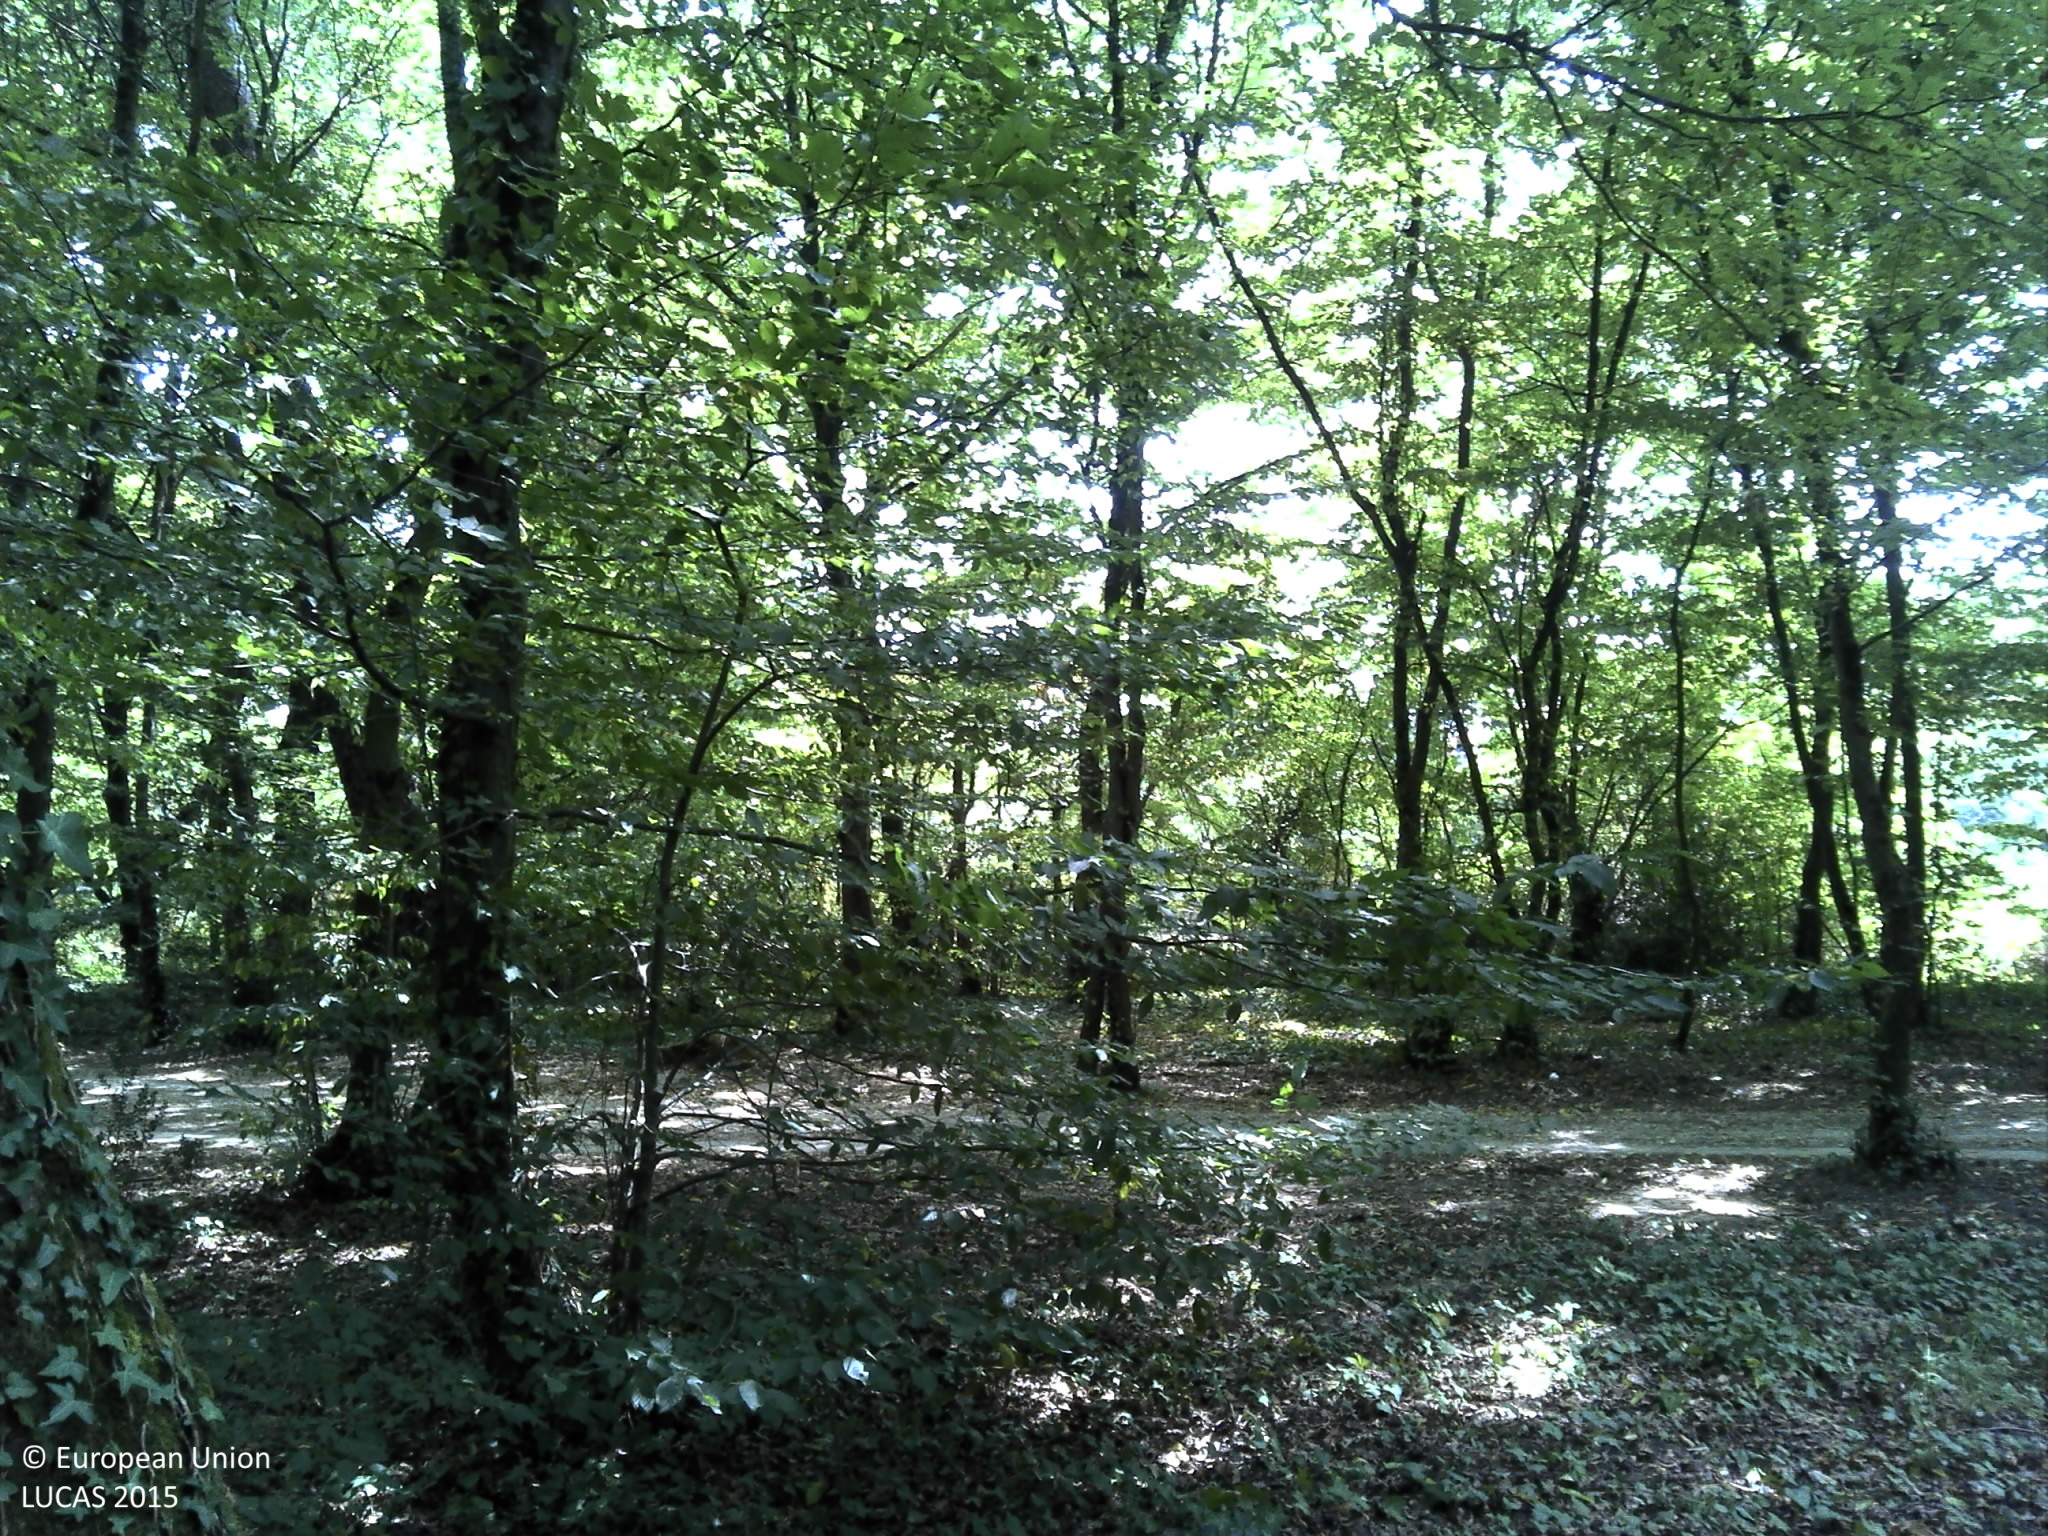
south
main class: Woodland
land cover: Broadleaved woodland
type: mesophytic deciduous forest
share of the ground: > 75 %
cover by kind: broadleaved forest trees 70 %, unconsolidated bare surface 15 %, herbaceous plants 10 %, coniferous forest trees 5 %
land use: Forestry
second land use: Sport
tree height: > 5 m
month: July
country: FR
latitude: 44.7878
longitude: -0.5975
